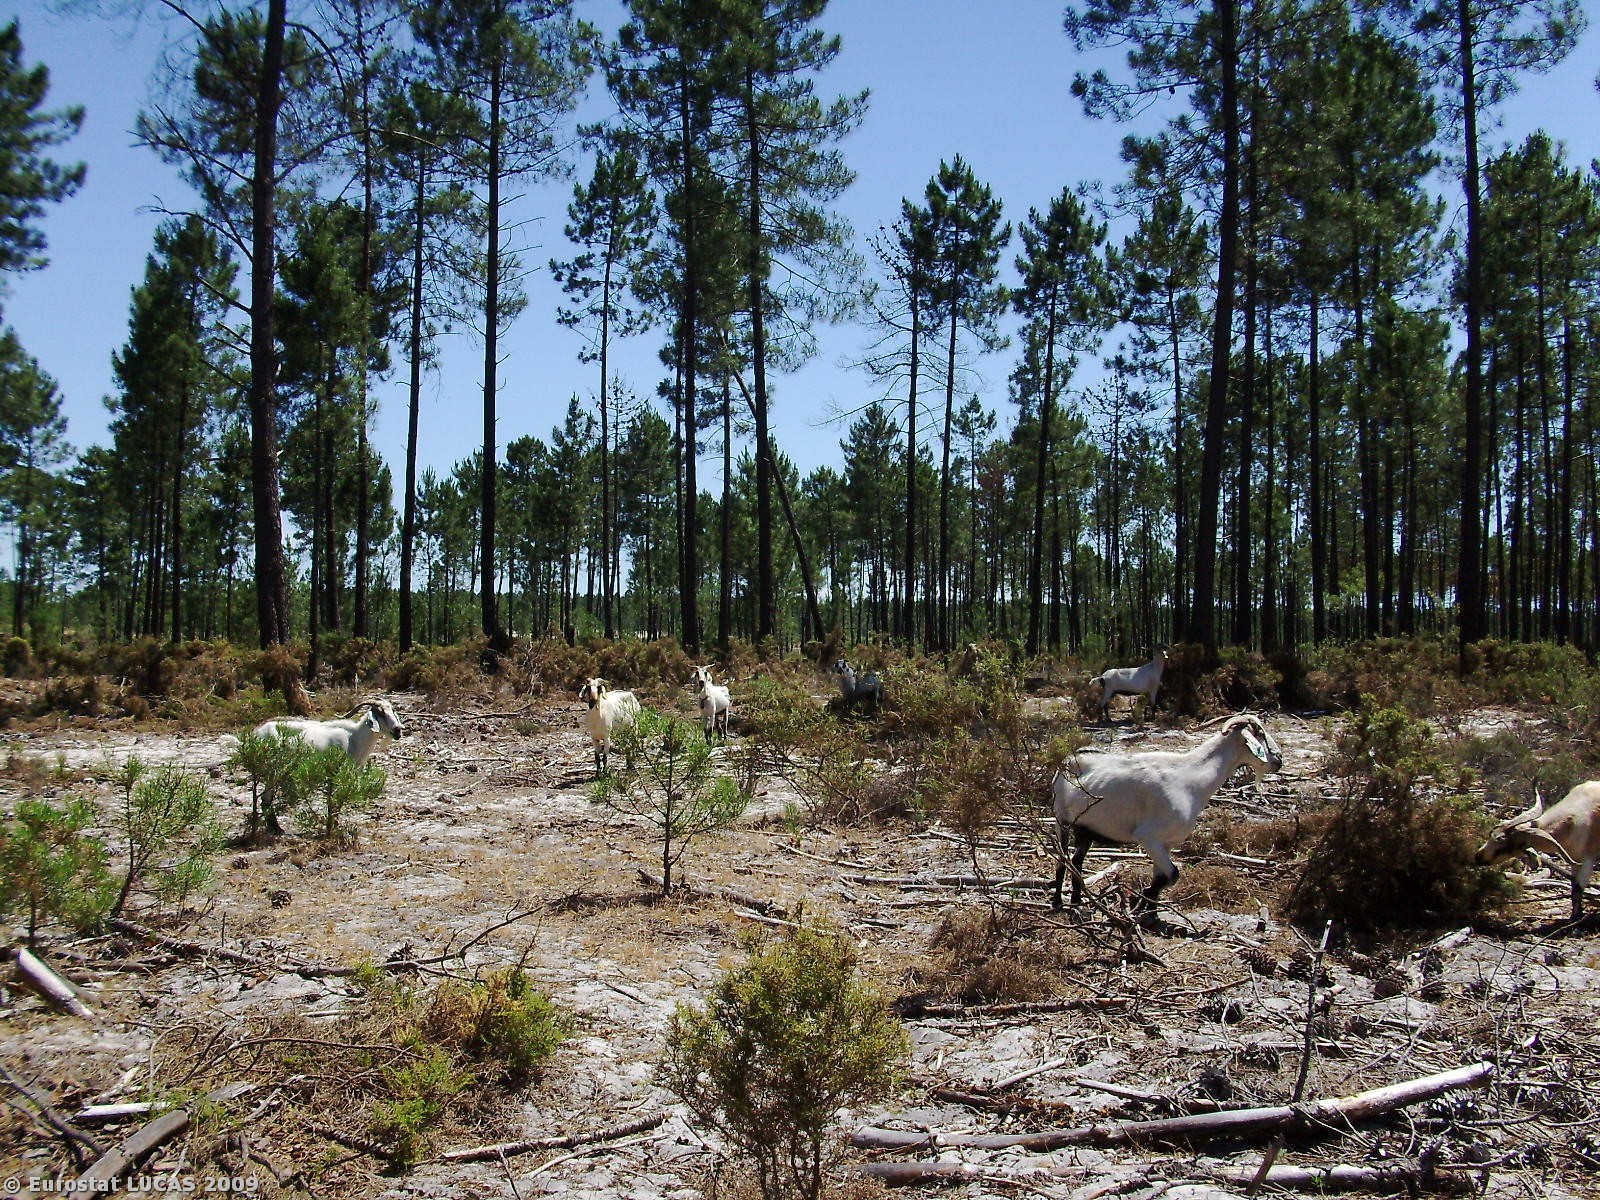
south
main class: Woodland
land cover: Coniferous woodland
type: coniferous forest of the mediterranean region
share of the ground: 50 - 75 %
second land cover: Shrubland with sparse tree cover
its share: 25 - 50 %
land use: Forestry
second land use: Agriculture (excluding fallow land and kitchen gardens)
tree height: > 5 m
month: June
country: PT
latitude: 38.2757
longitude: -8.6507
